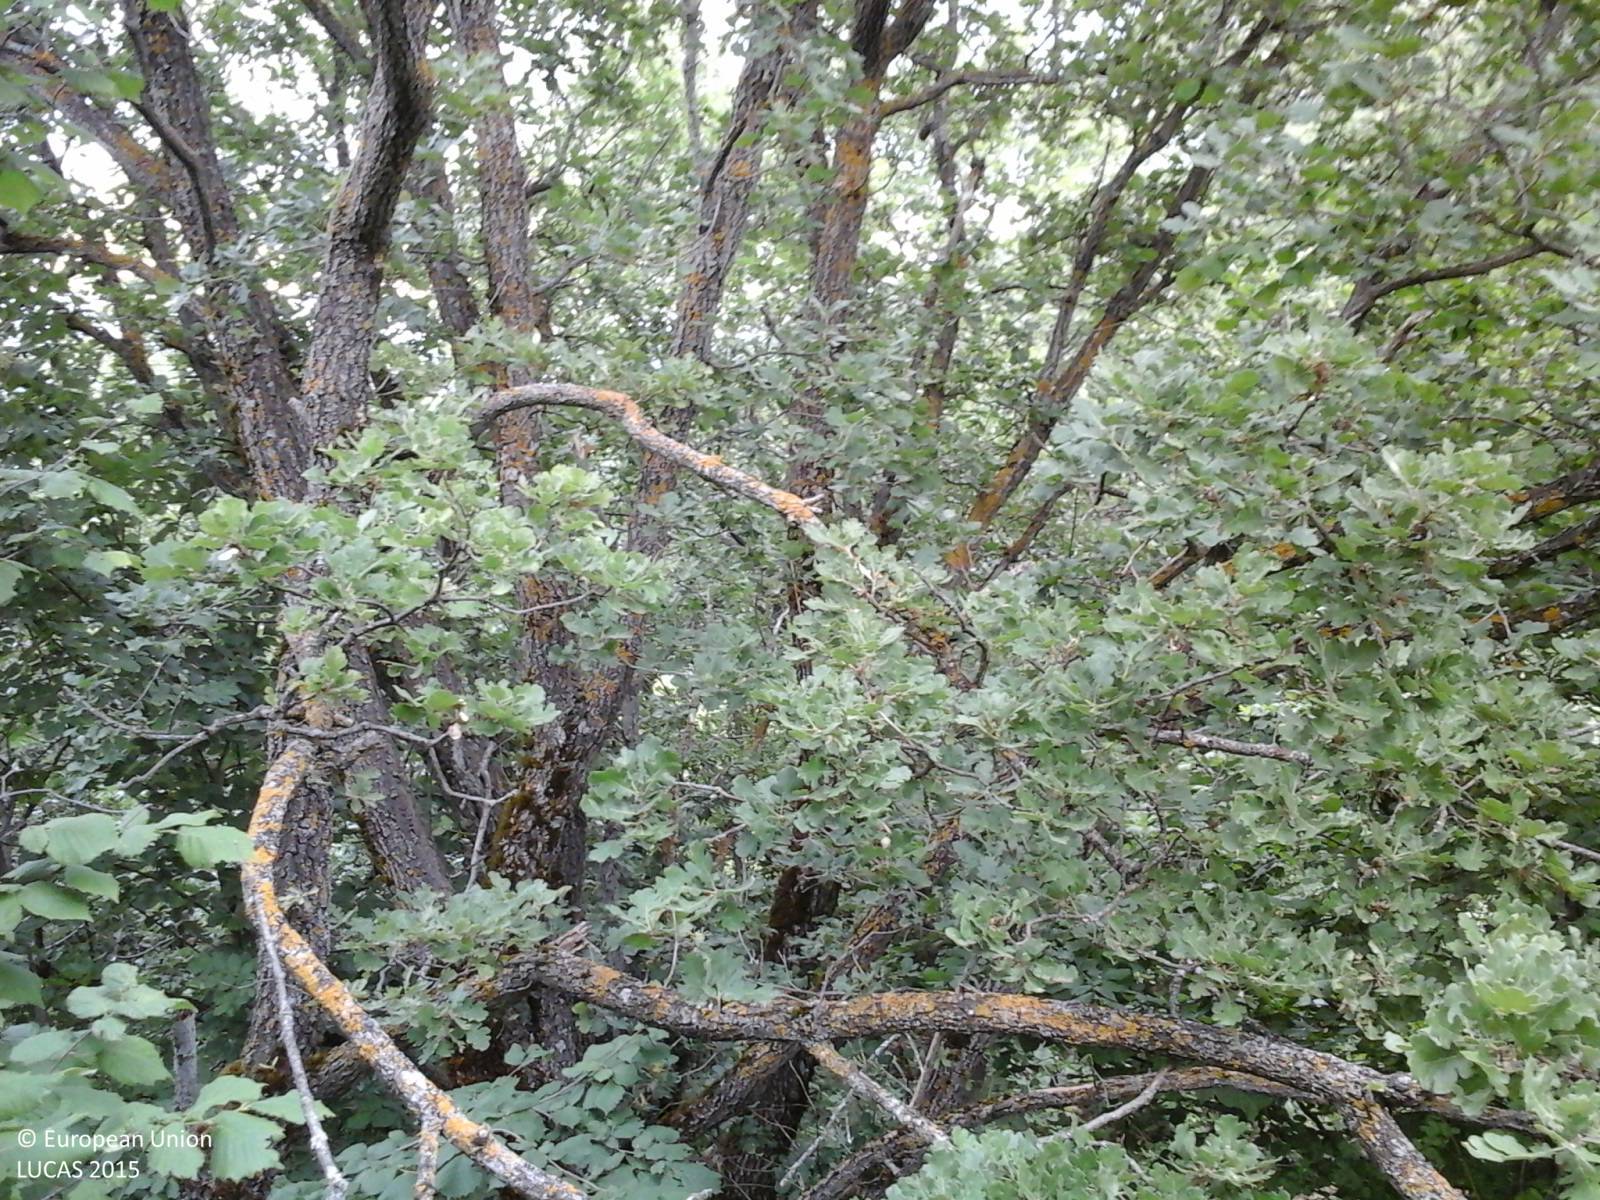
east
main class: Woodland
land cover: Broadleaved woodland
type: thermophilous deciduous forest
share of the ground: > 75 %
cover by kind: broadleaved forest trees 80 %, shrubs 20 %
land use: Semi-natural and natural areas not in use
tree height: > 5 m
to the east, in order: Broadleaved woodland; Shrubland with sparse tree cover; Broadleaved woodland; Grass margins; Paved roads, cycling and walking lanes; Grass margins; Broadleaved woodland; Shrubland with sparse tree cover; Broadleaved woodland; Paved roads, cycling and walking lanes; Grass margins; Broadleaved woodland
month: June
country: IT
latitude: 42.0793
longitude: 13.7227
